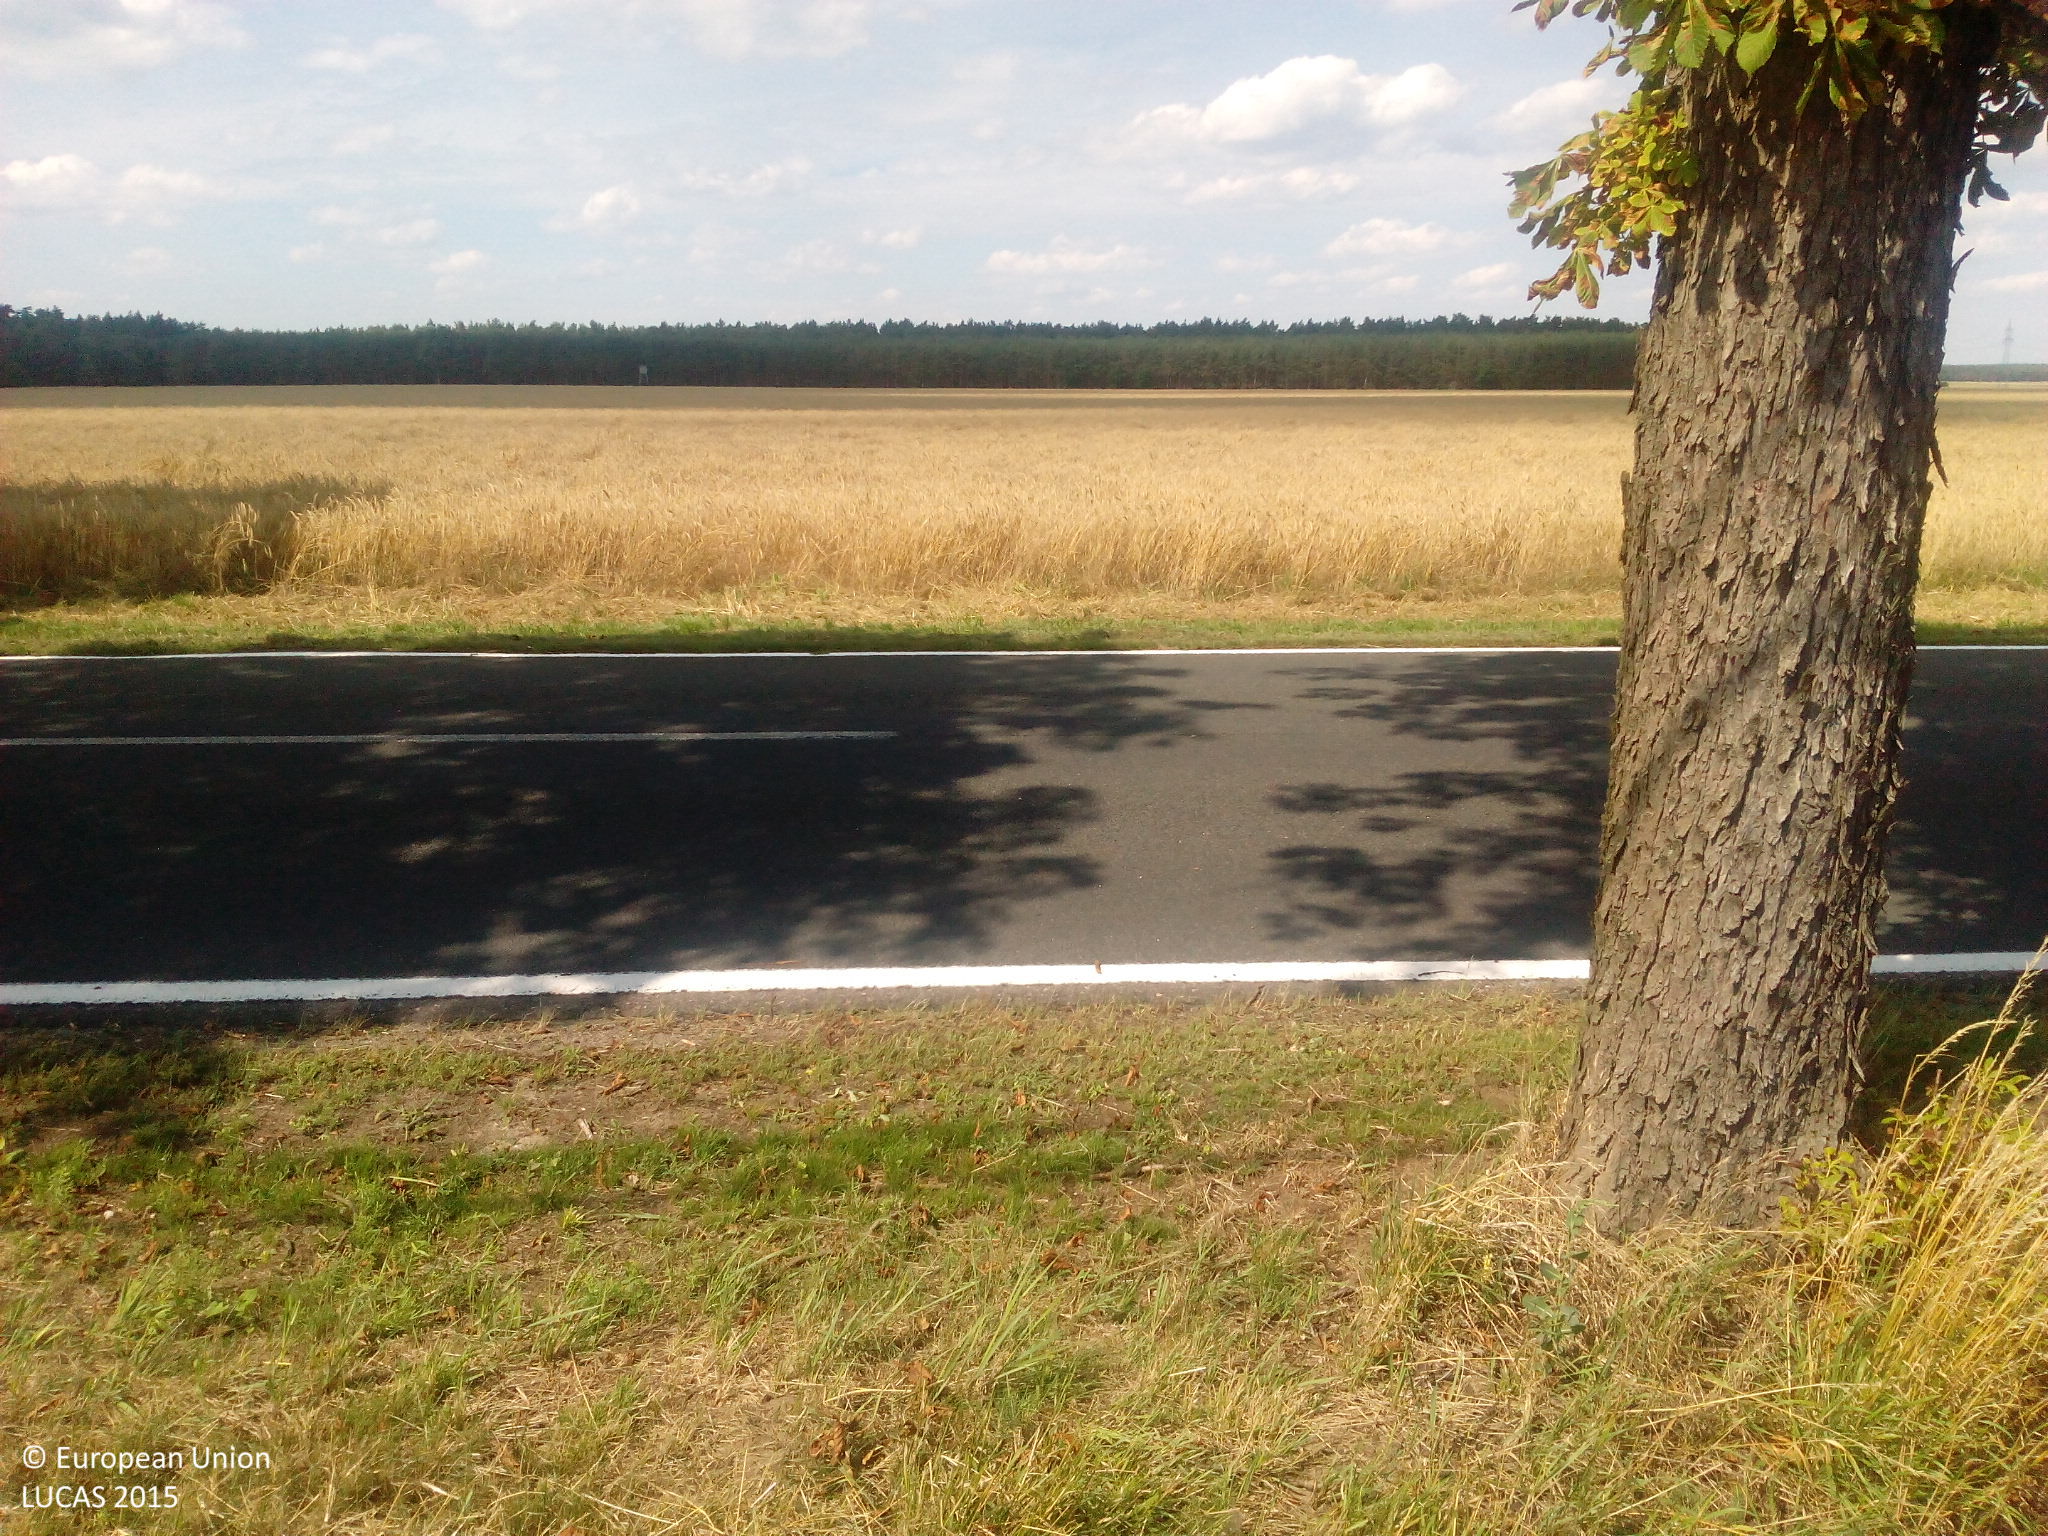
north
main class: Cropland
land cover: Rye
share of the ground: > 75 %
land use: Agriculture (excluding fallow land and kitchen gardens)
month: July
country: DE
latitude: 51.9234
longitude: 12.3117
